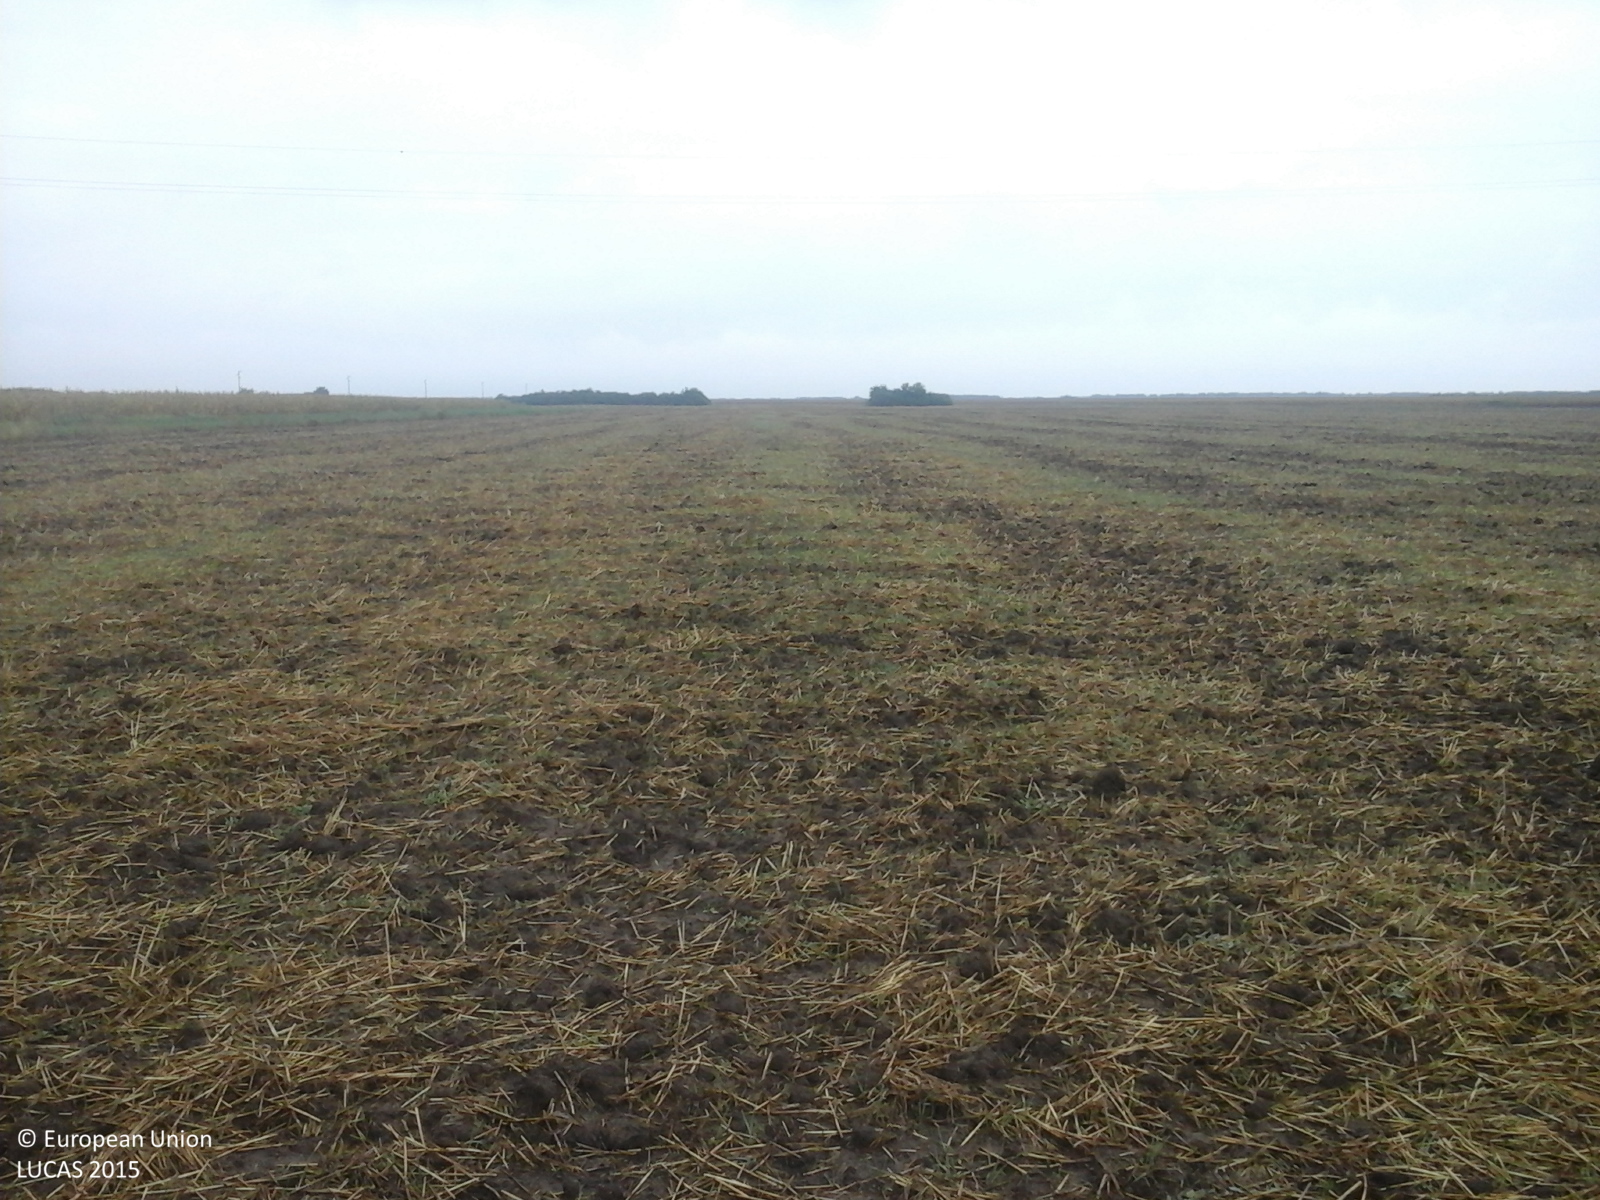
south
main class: Cropland
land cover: Common wheat
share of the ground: < 10 %
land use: Agriculture (excluding fallow land and kitchen gardens)
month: August
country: RO
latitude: 45.6211
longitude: 21.1483
